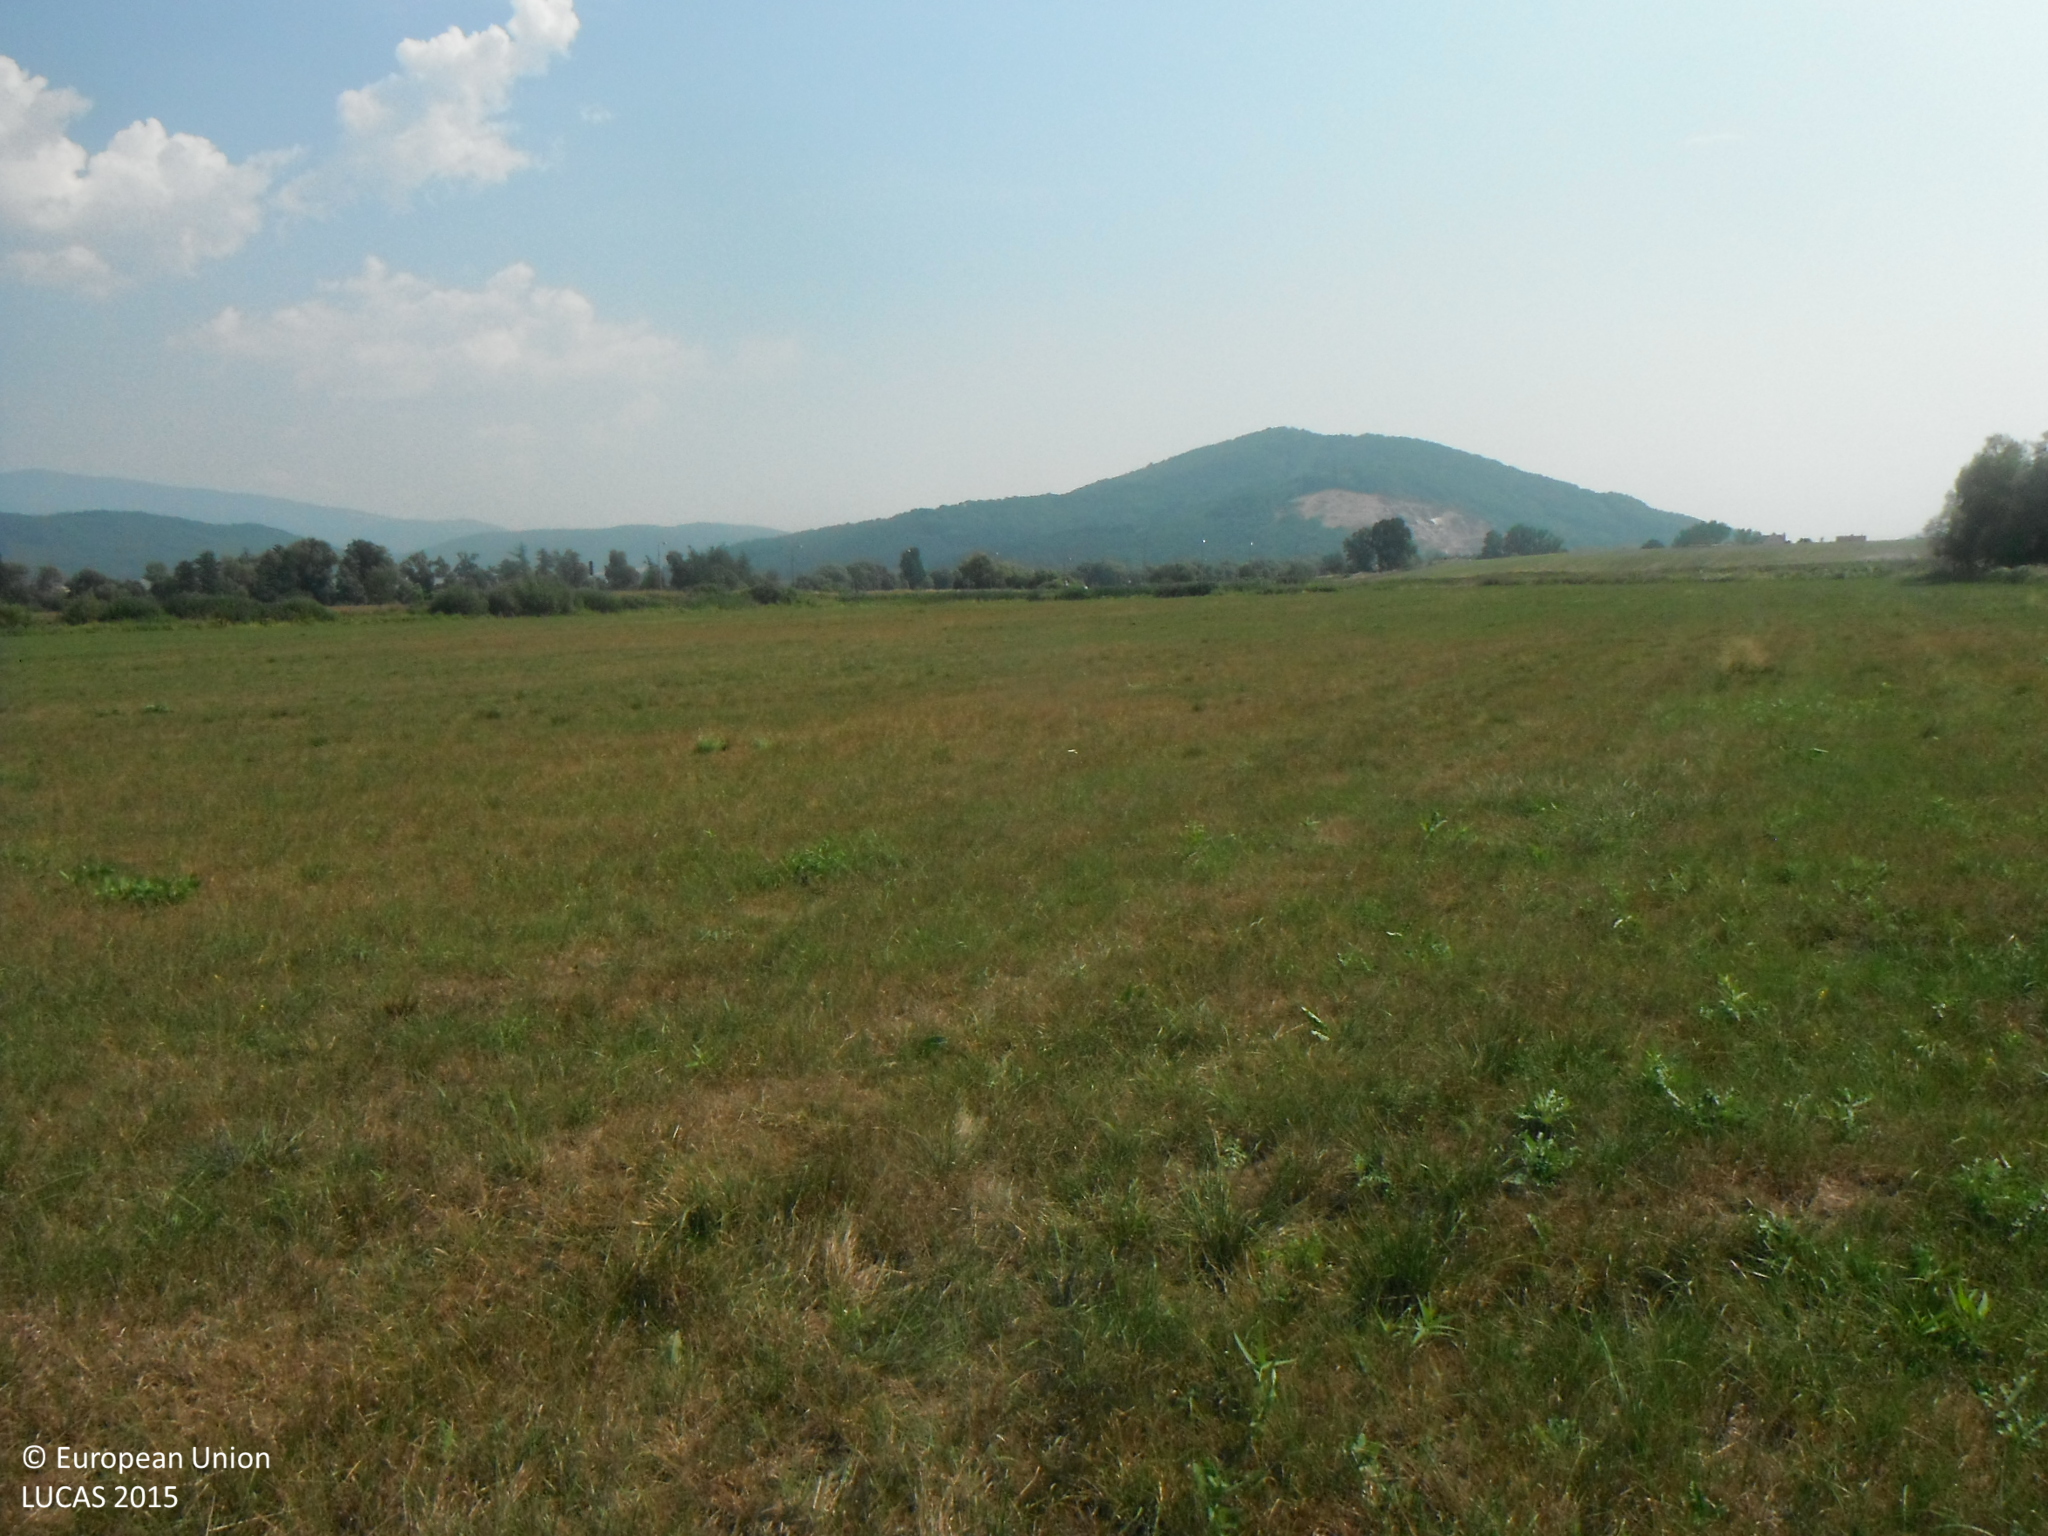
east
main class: Grassland
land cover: Grassland without tree/shrub cover
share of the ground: > 75 %
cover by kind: herbaceous plants 100 %
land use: Agriculture (excluding fallow land and kitchen gardens)
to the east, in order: Grassland without tree/shrub cover
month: August
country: SK
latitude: 48.5538
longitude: 19.3037
